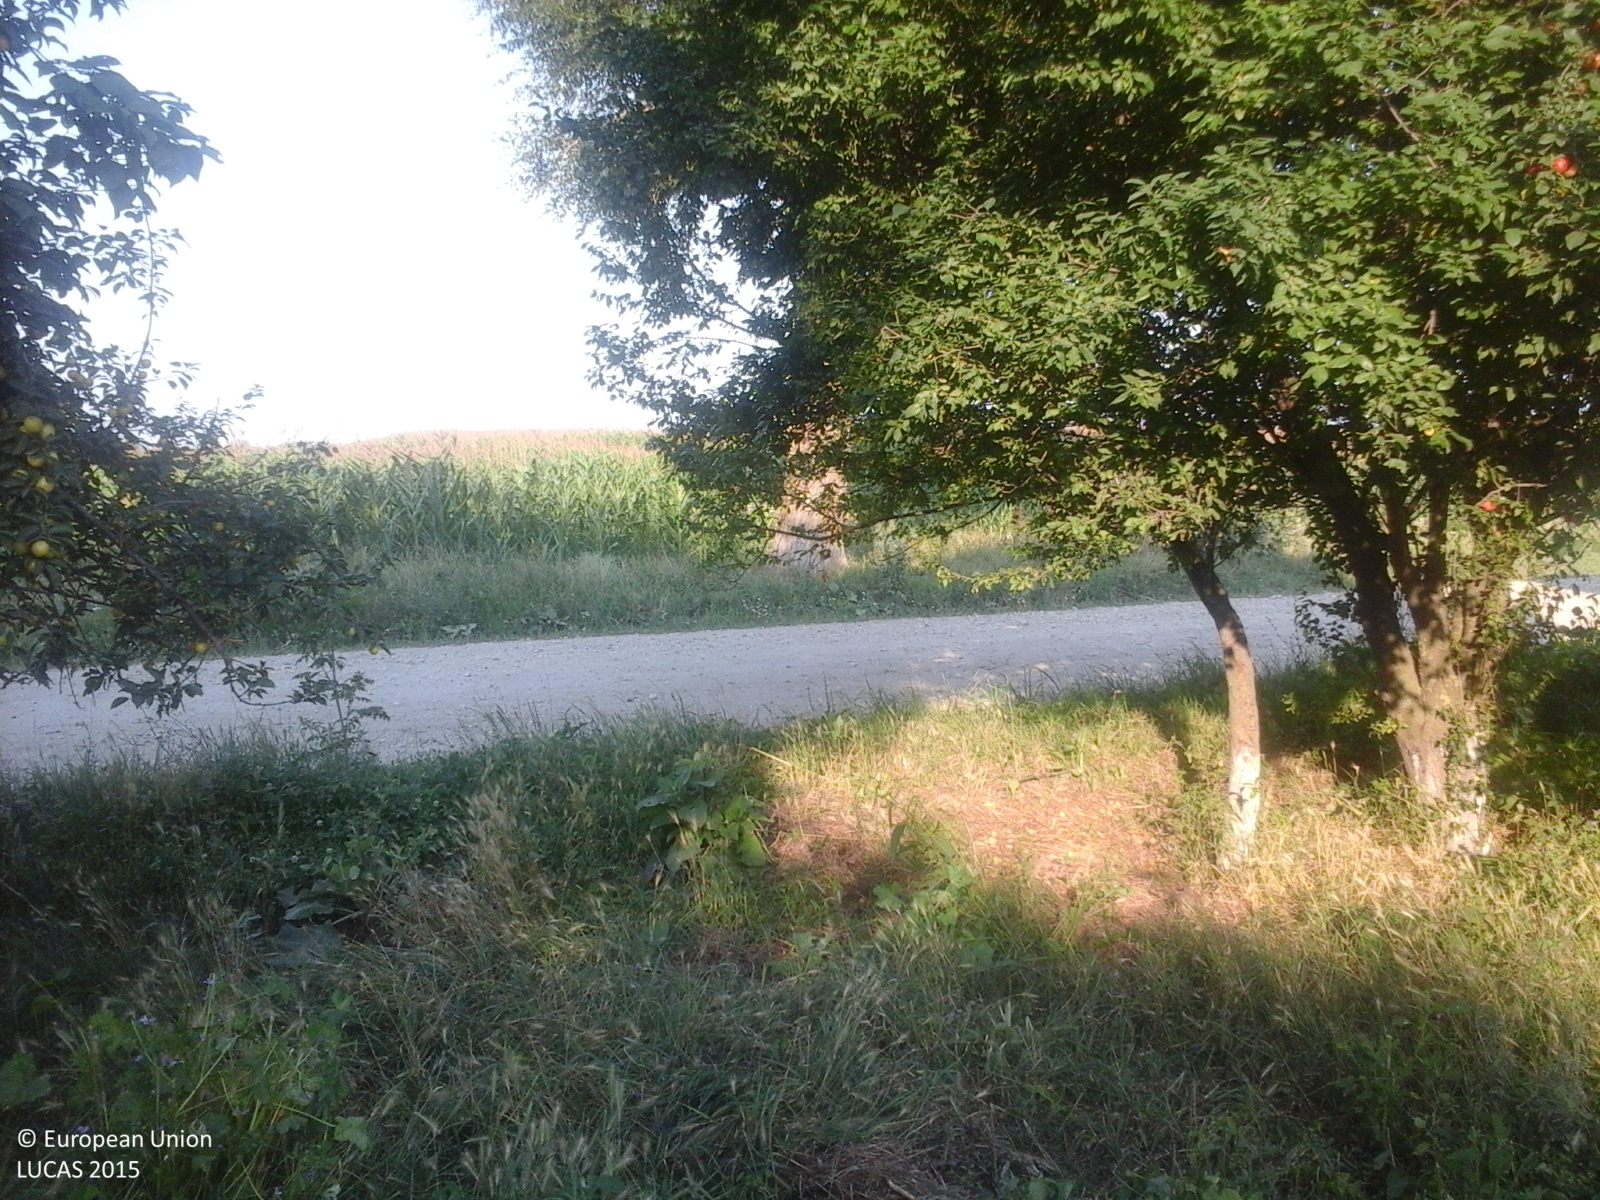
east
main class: Cropland
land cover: Maize
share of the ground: > 75 %
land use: Agriculture (excluding fallow land and kitchen gardens)
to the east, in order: Maize; Electric lines; Grassland without tree/shrub cover; Lines of trees; Paved roads, cycling and walking lanes; Lines of trees; Grass margins; Maize
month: July
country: RO
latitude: 44.6073
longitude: 25.5028
